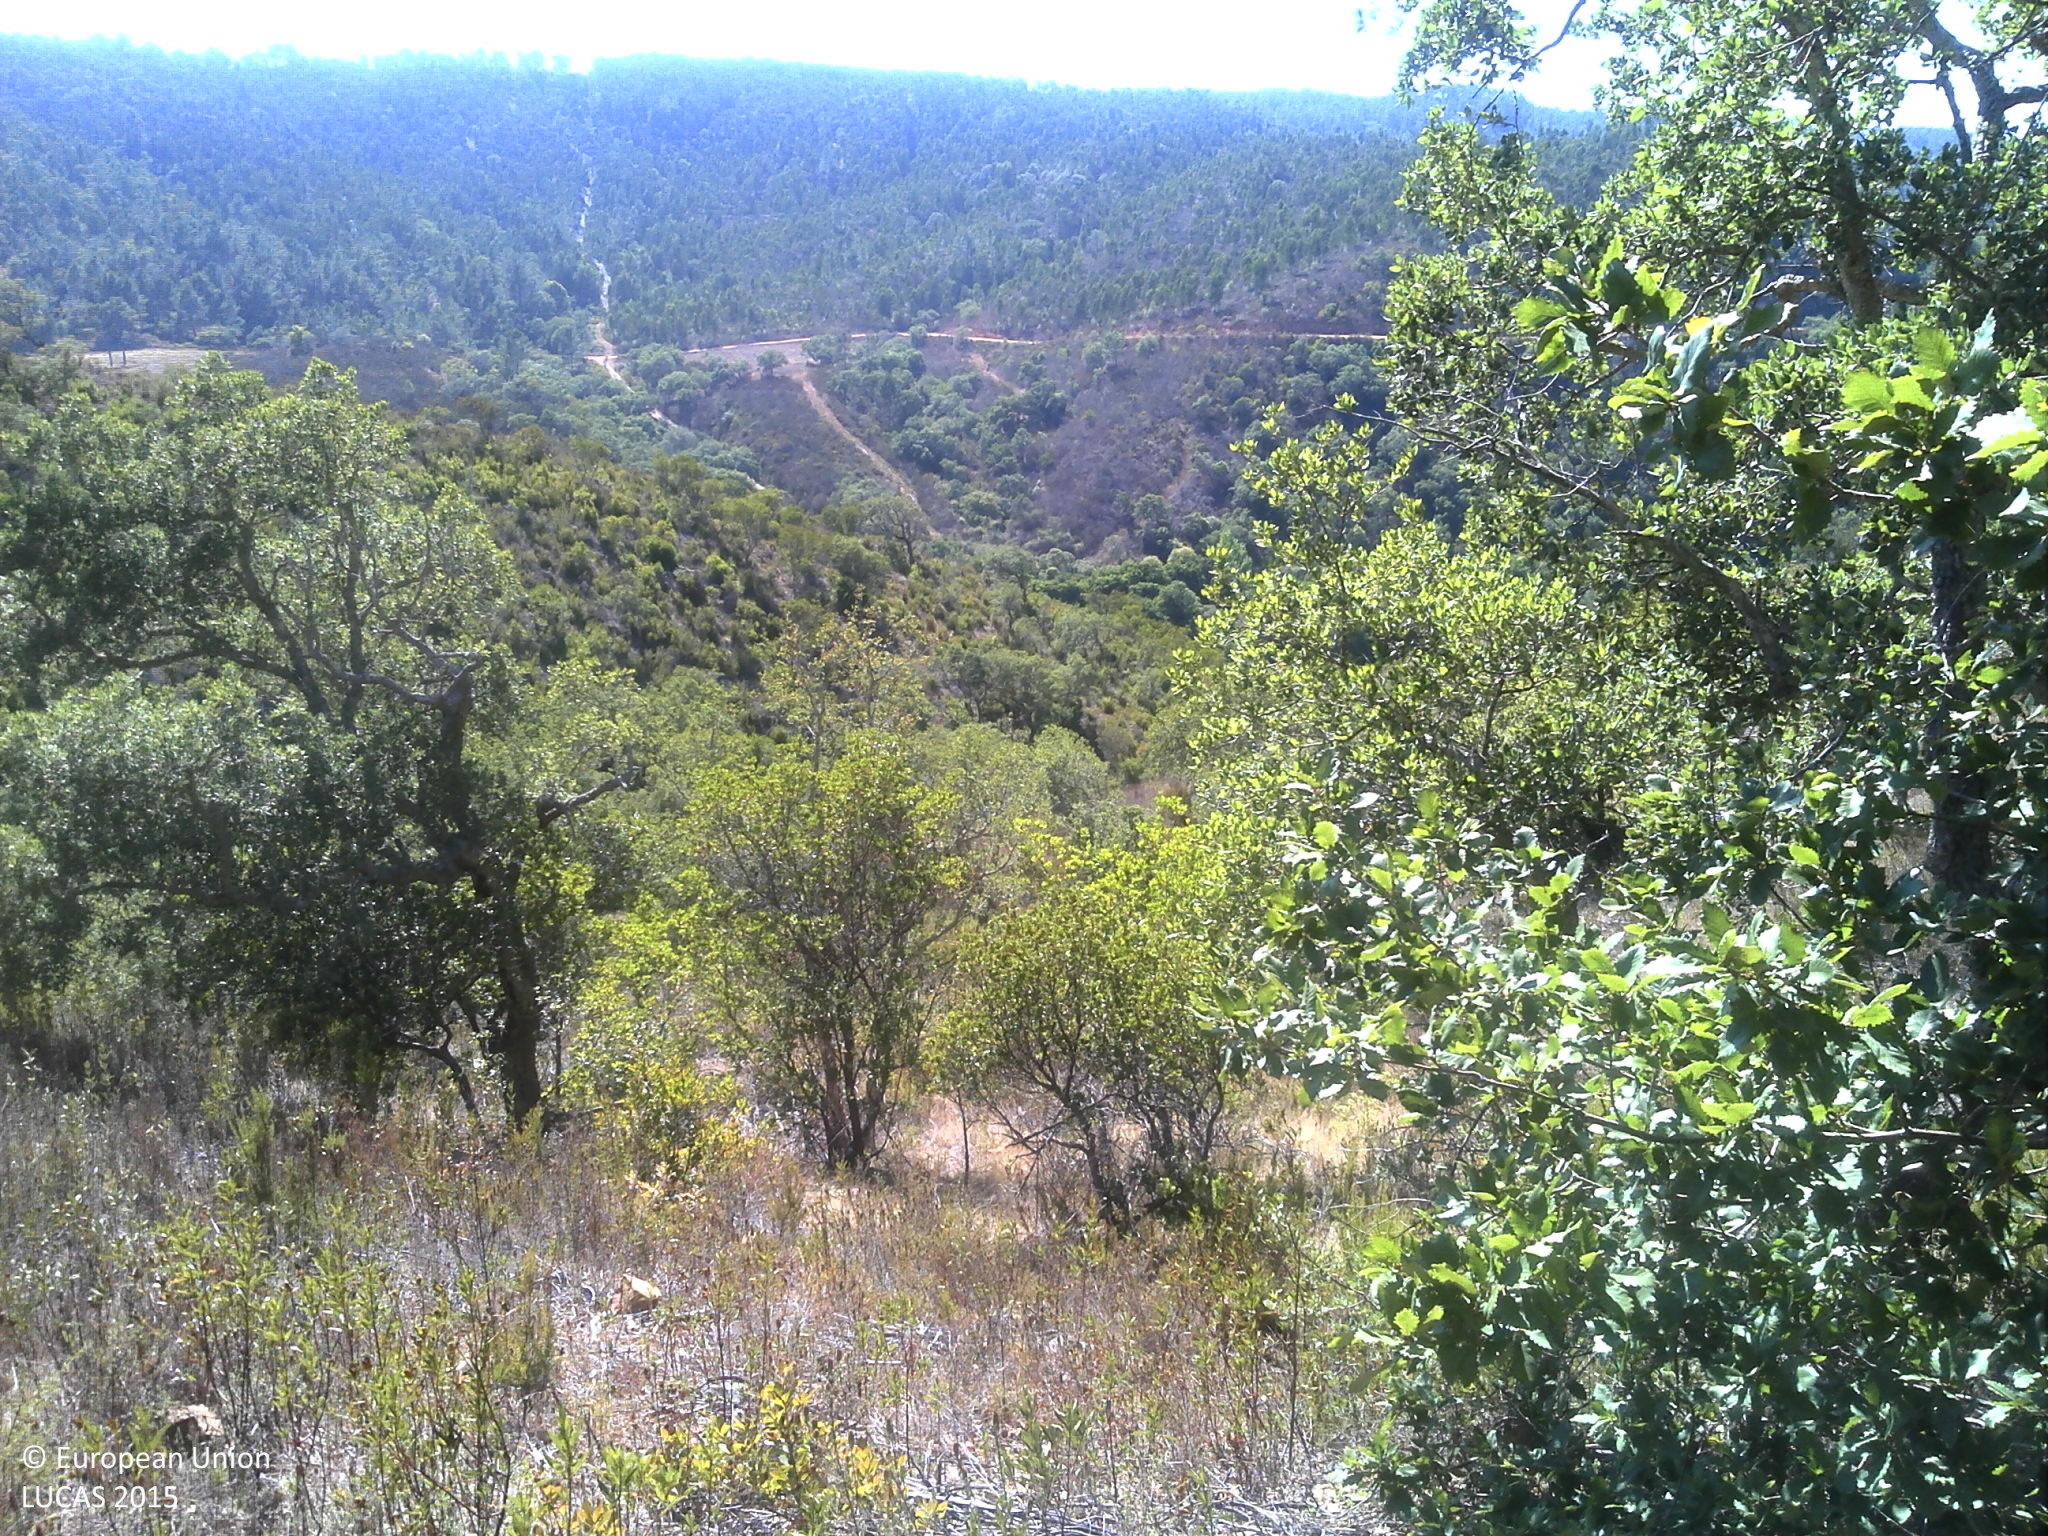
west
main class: Woodland
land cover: Broadleaved woodland
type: broadleaved evergreen forest
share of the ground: 25 - 50 %
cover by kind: broadleaved forest trees 40 %, shrubs 20 %, herbaceous plants 20 %, unconsolidated bare surface 20 %
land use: Forestry
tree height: > 5 m
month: August
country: PT
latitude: 37.4070
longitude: -8.7337
